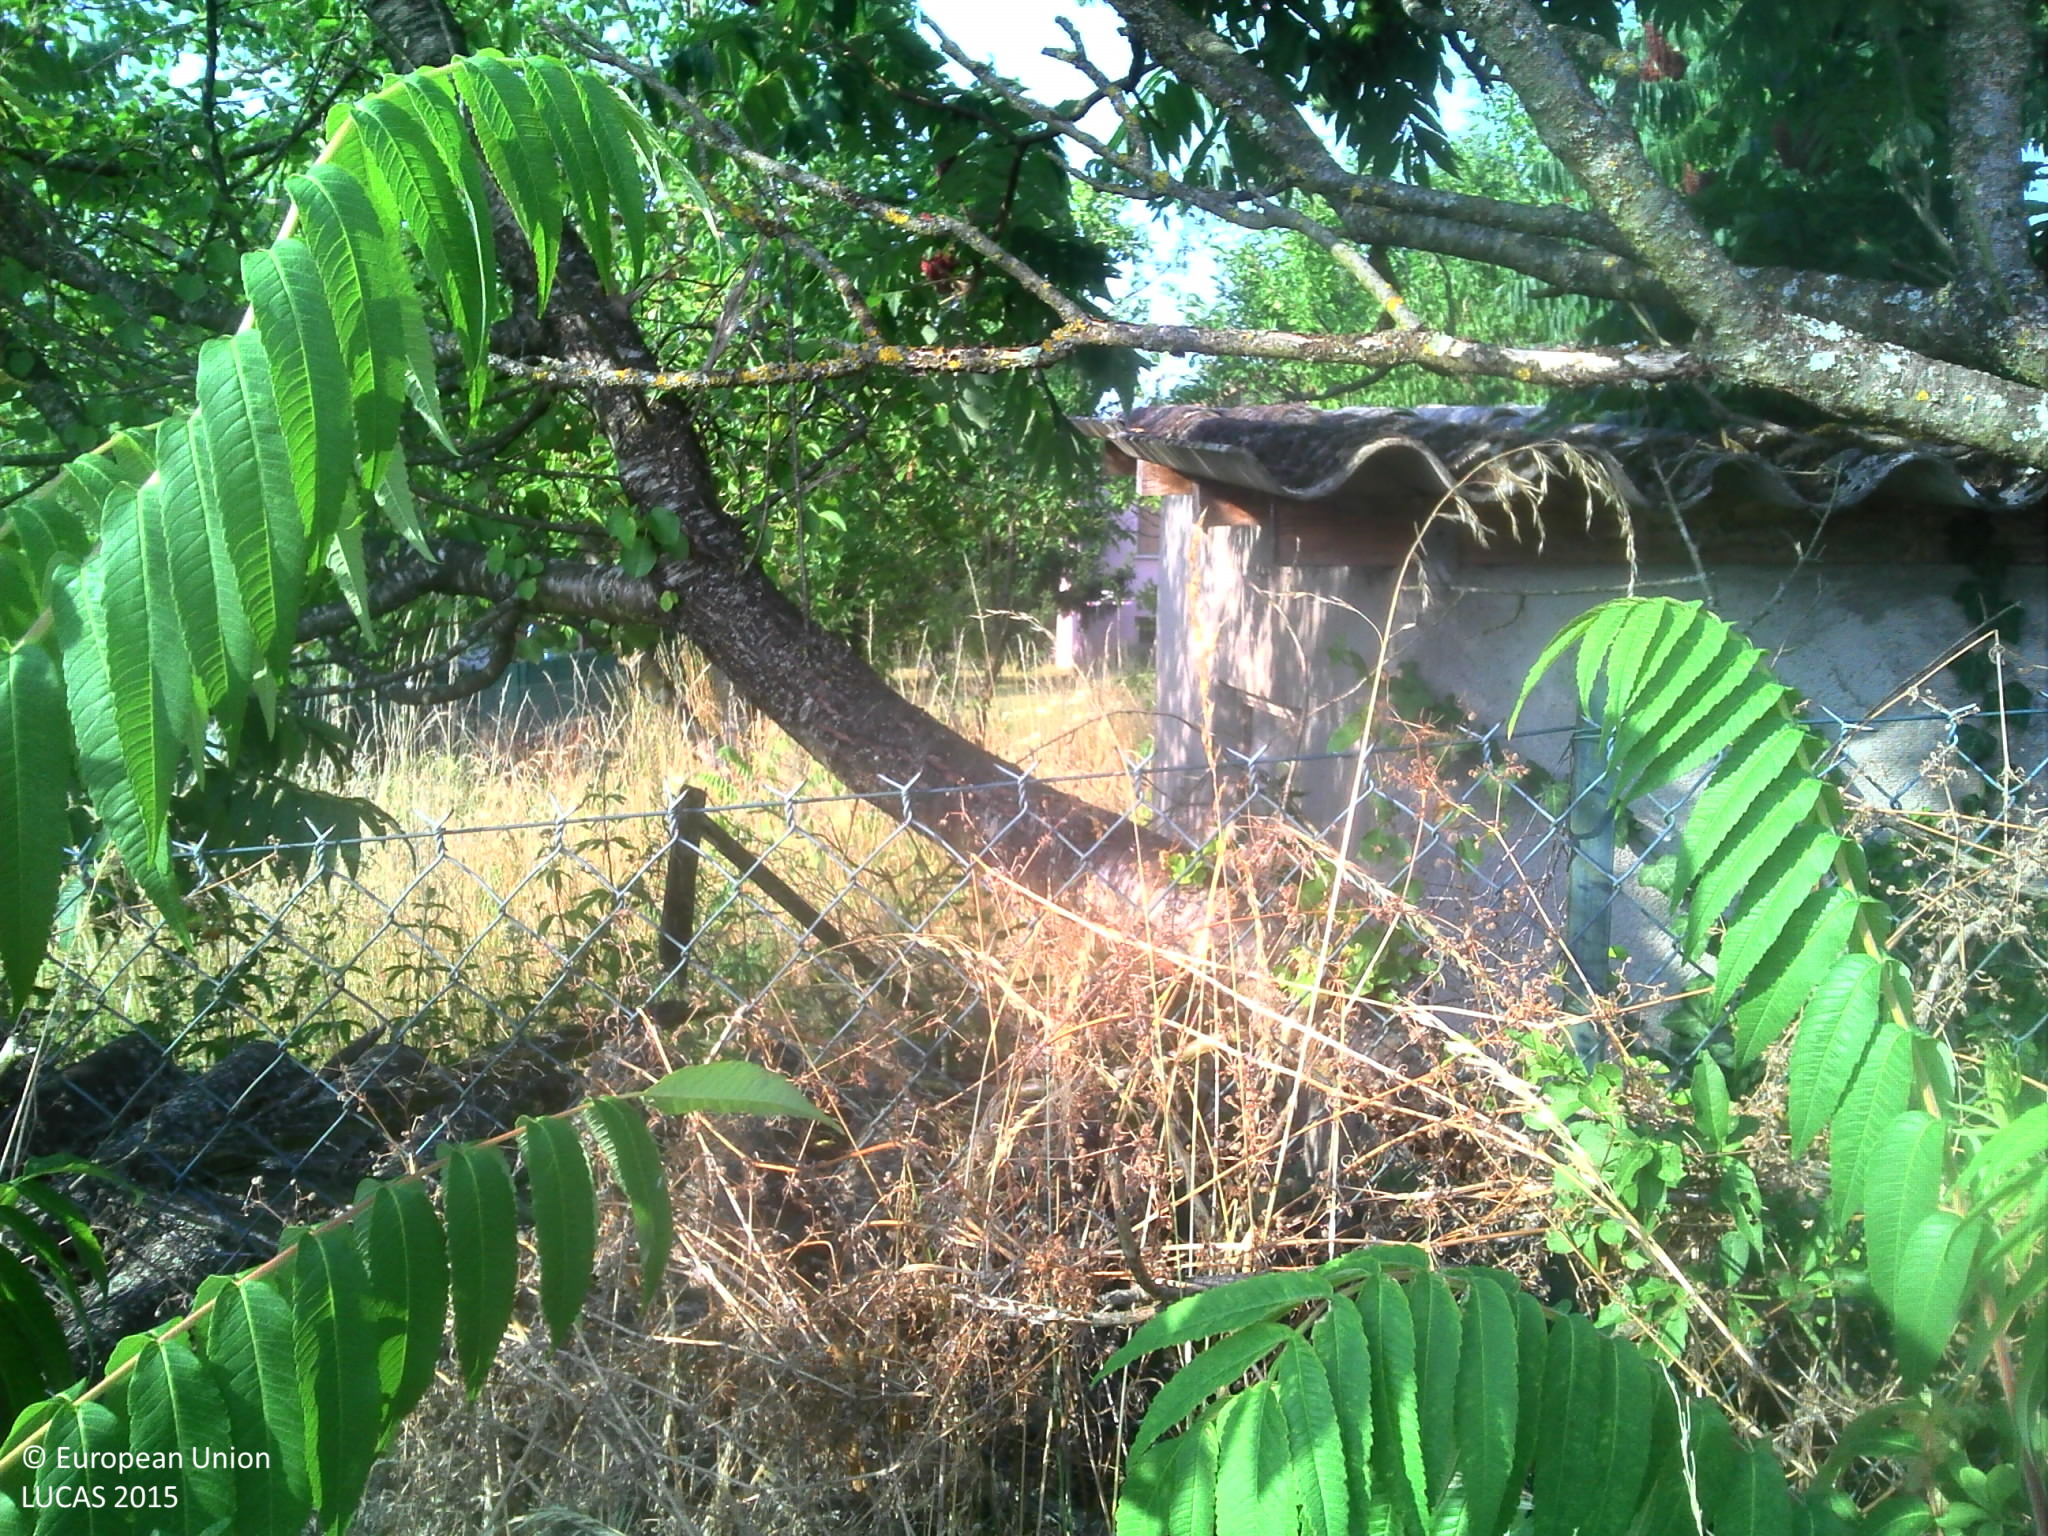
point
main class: Grassland
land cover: Grassland with sparse tree/shrub cover
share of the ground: > 75 %
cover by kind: herbaceous plants 95 %, coniferous forest trees 5 %
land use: Residential
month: July
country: FR
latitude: 45.6476
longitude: 5.1924
